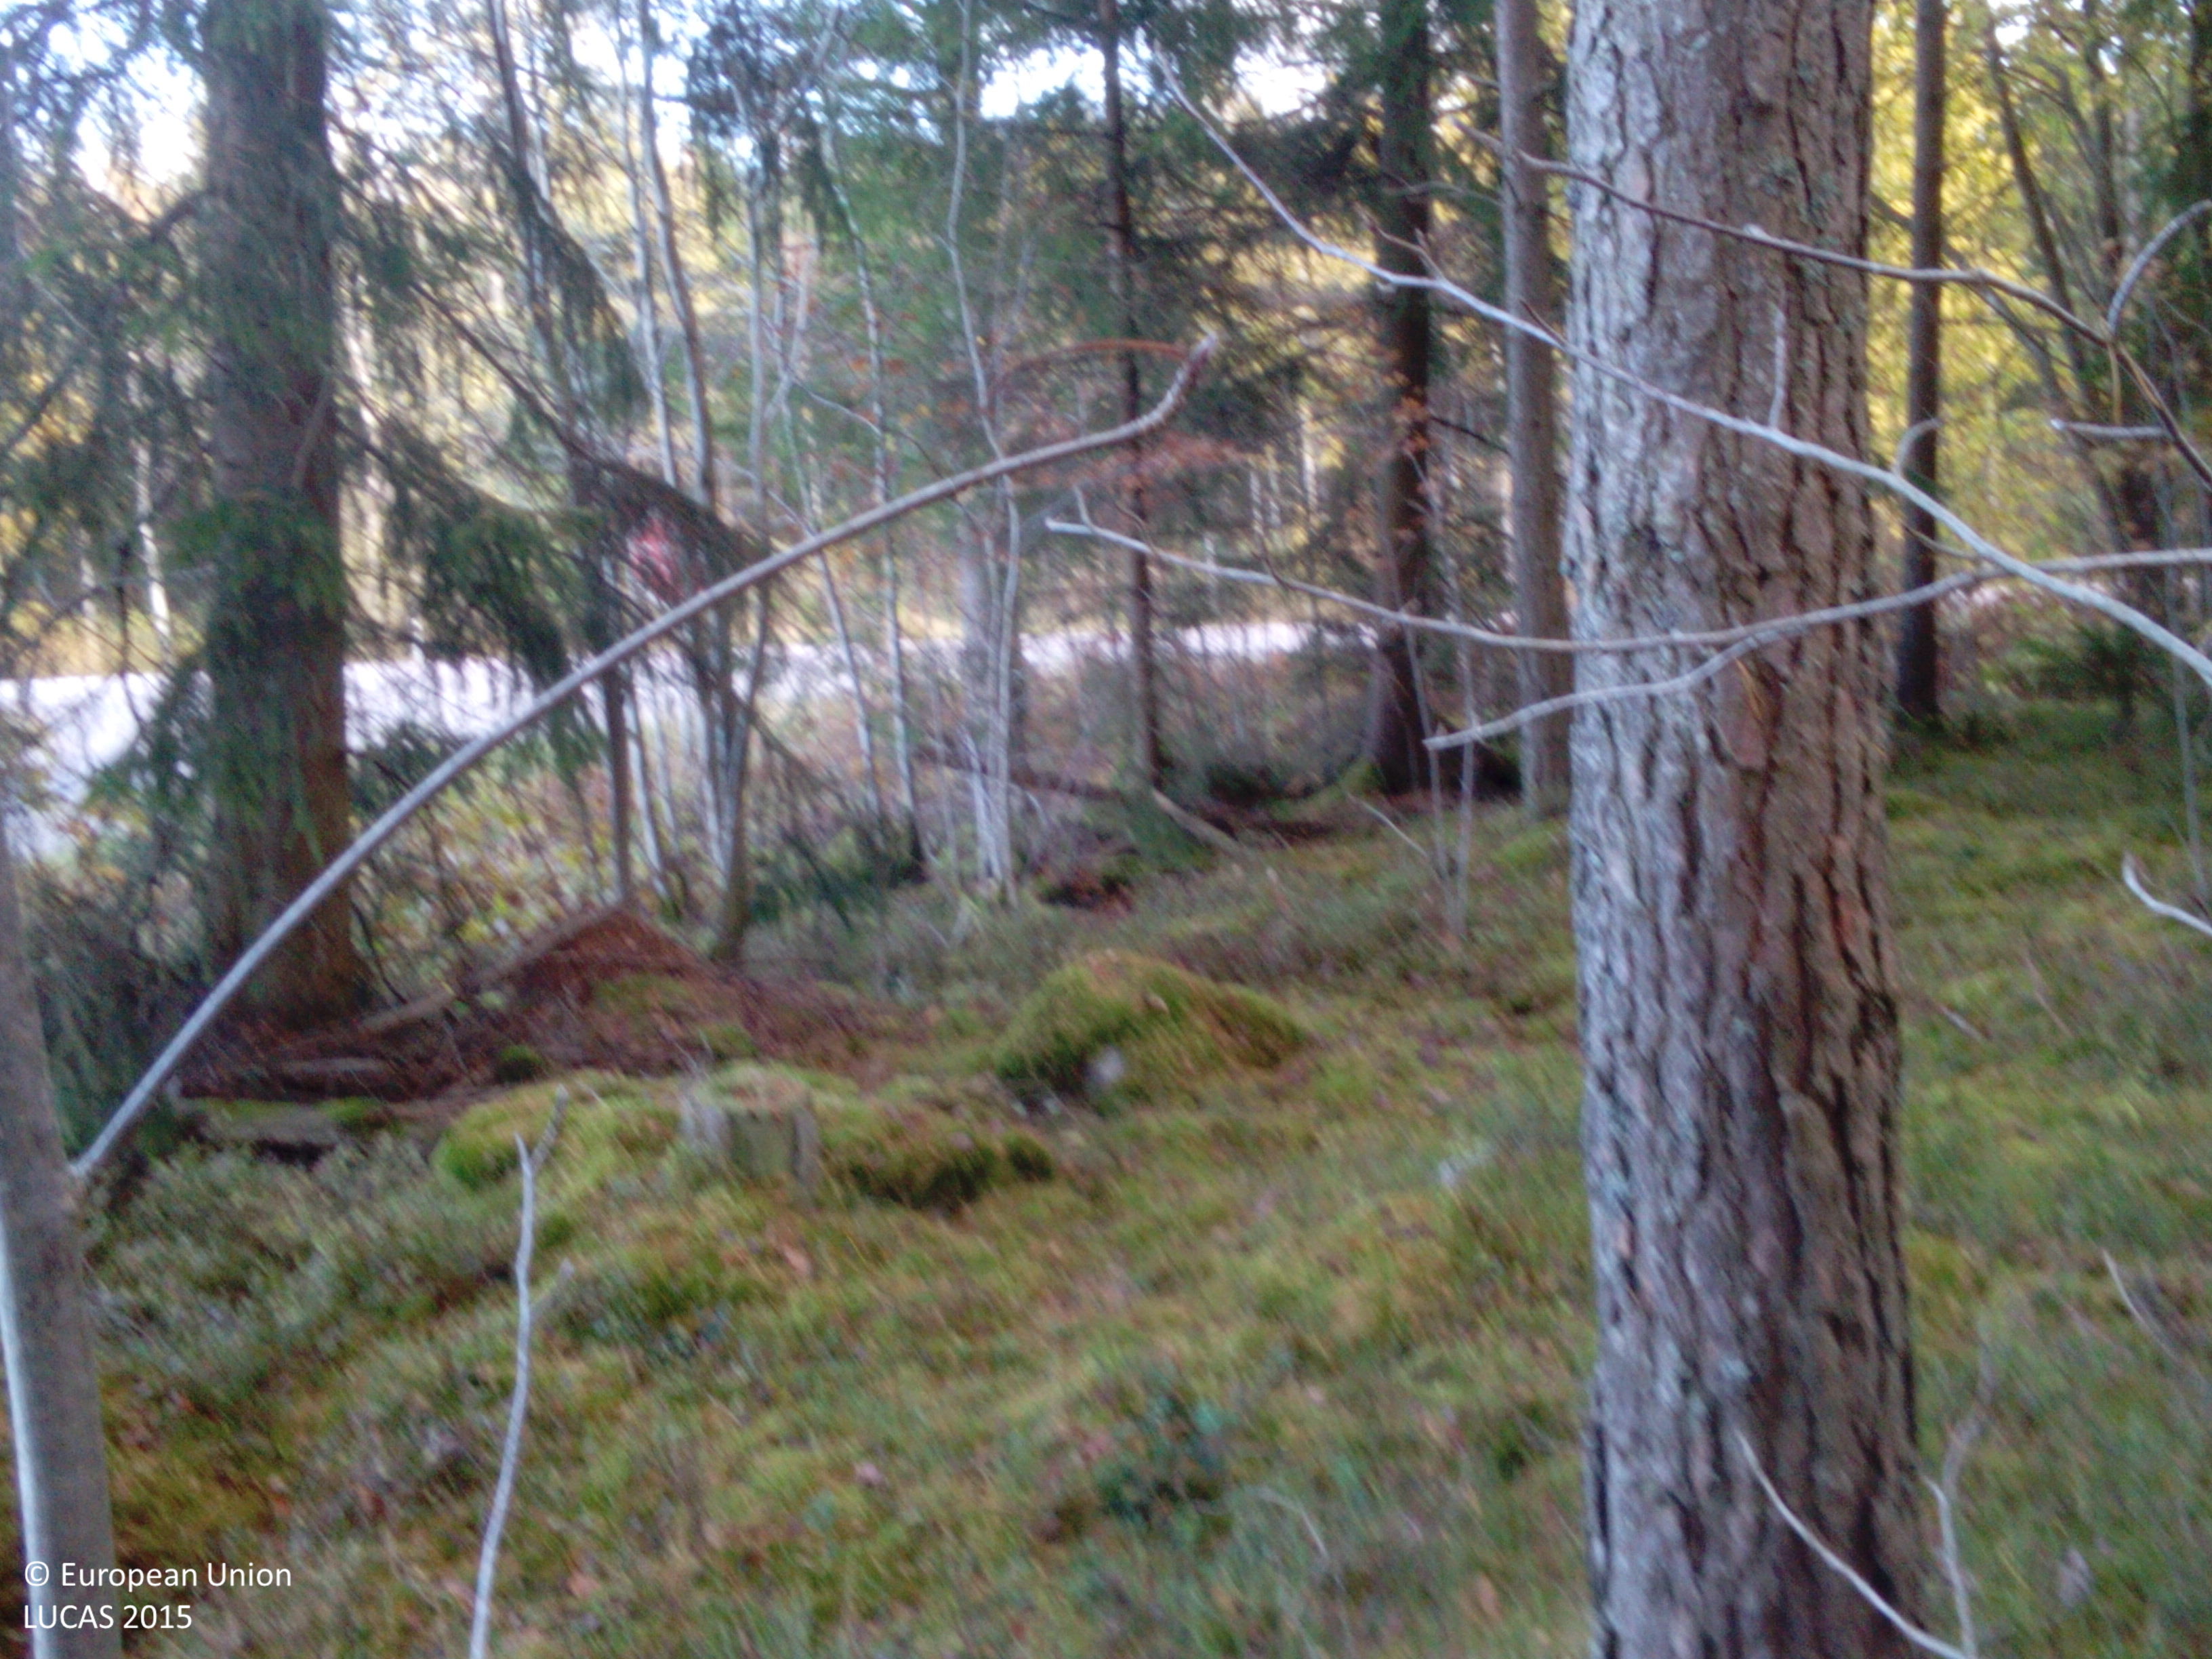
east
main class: Woodland
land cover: Other coniferous woodland
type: boreal forest
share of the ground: > 75 %
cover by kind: coniferous forest trees 85 %, lichens and mosses 10 %, herbaceous plants 5 %
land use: Forestry
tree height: > 5 m
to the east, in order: Other coniferous woodland; Grass margins; Ditches and canals; Grass margins; Paved roads, cycling and walking lanes; Grass margins; Ditches and canals; Broadleaved woodland; Spruce dominated mixed woodland; Other coniferous woodland
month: October
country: SE
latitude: 59.0325
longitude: 16.2139
